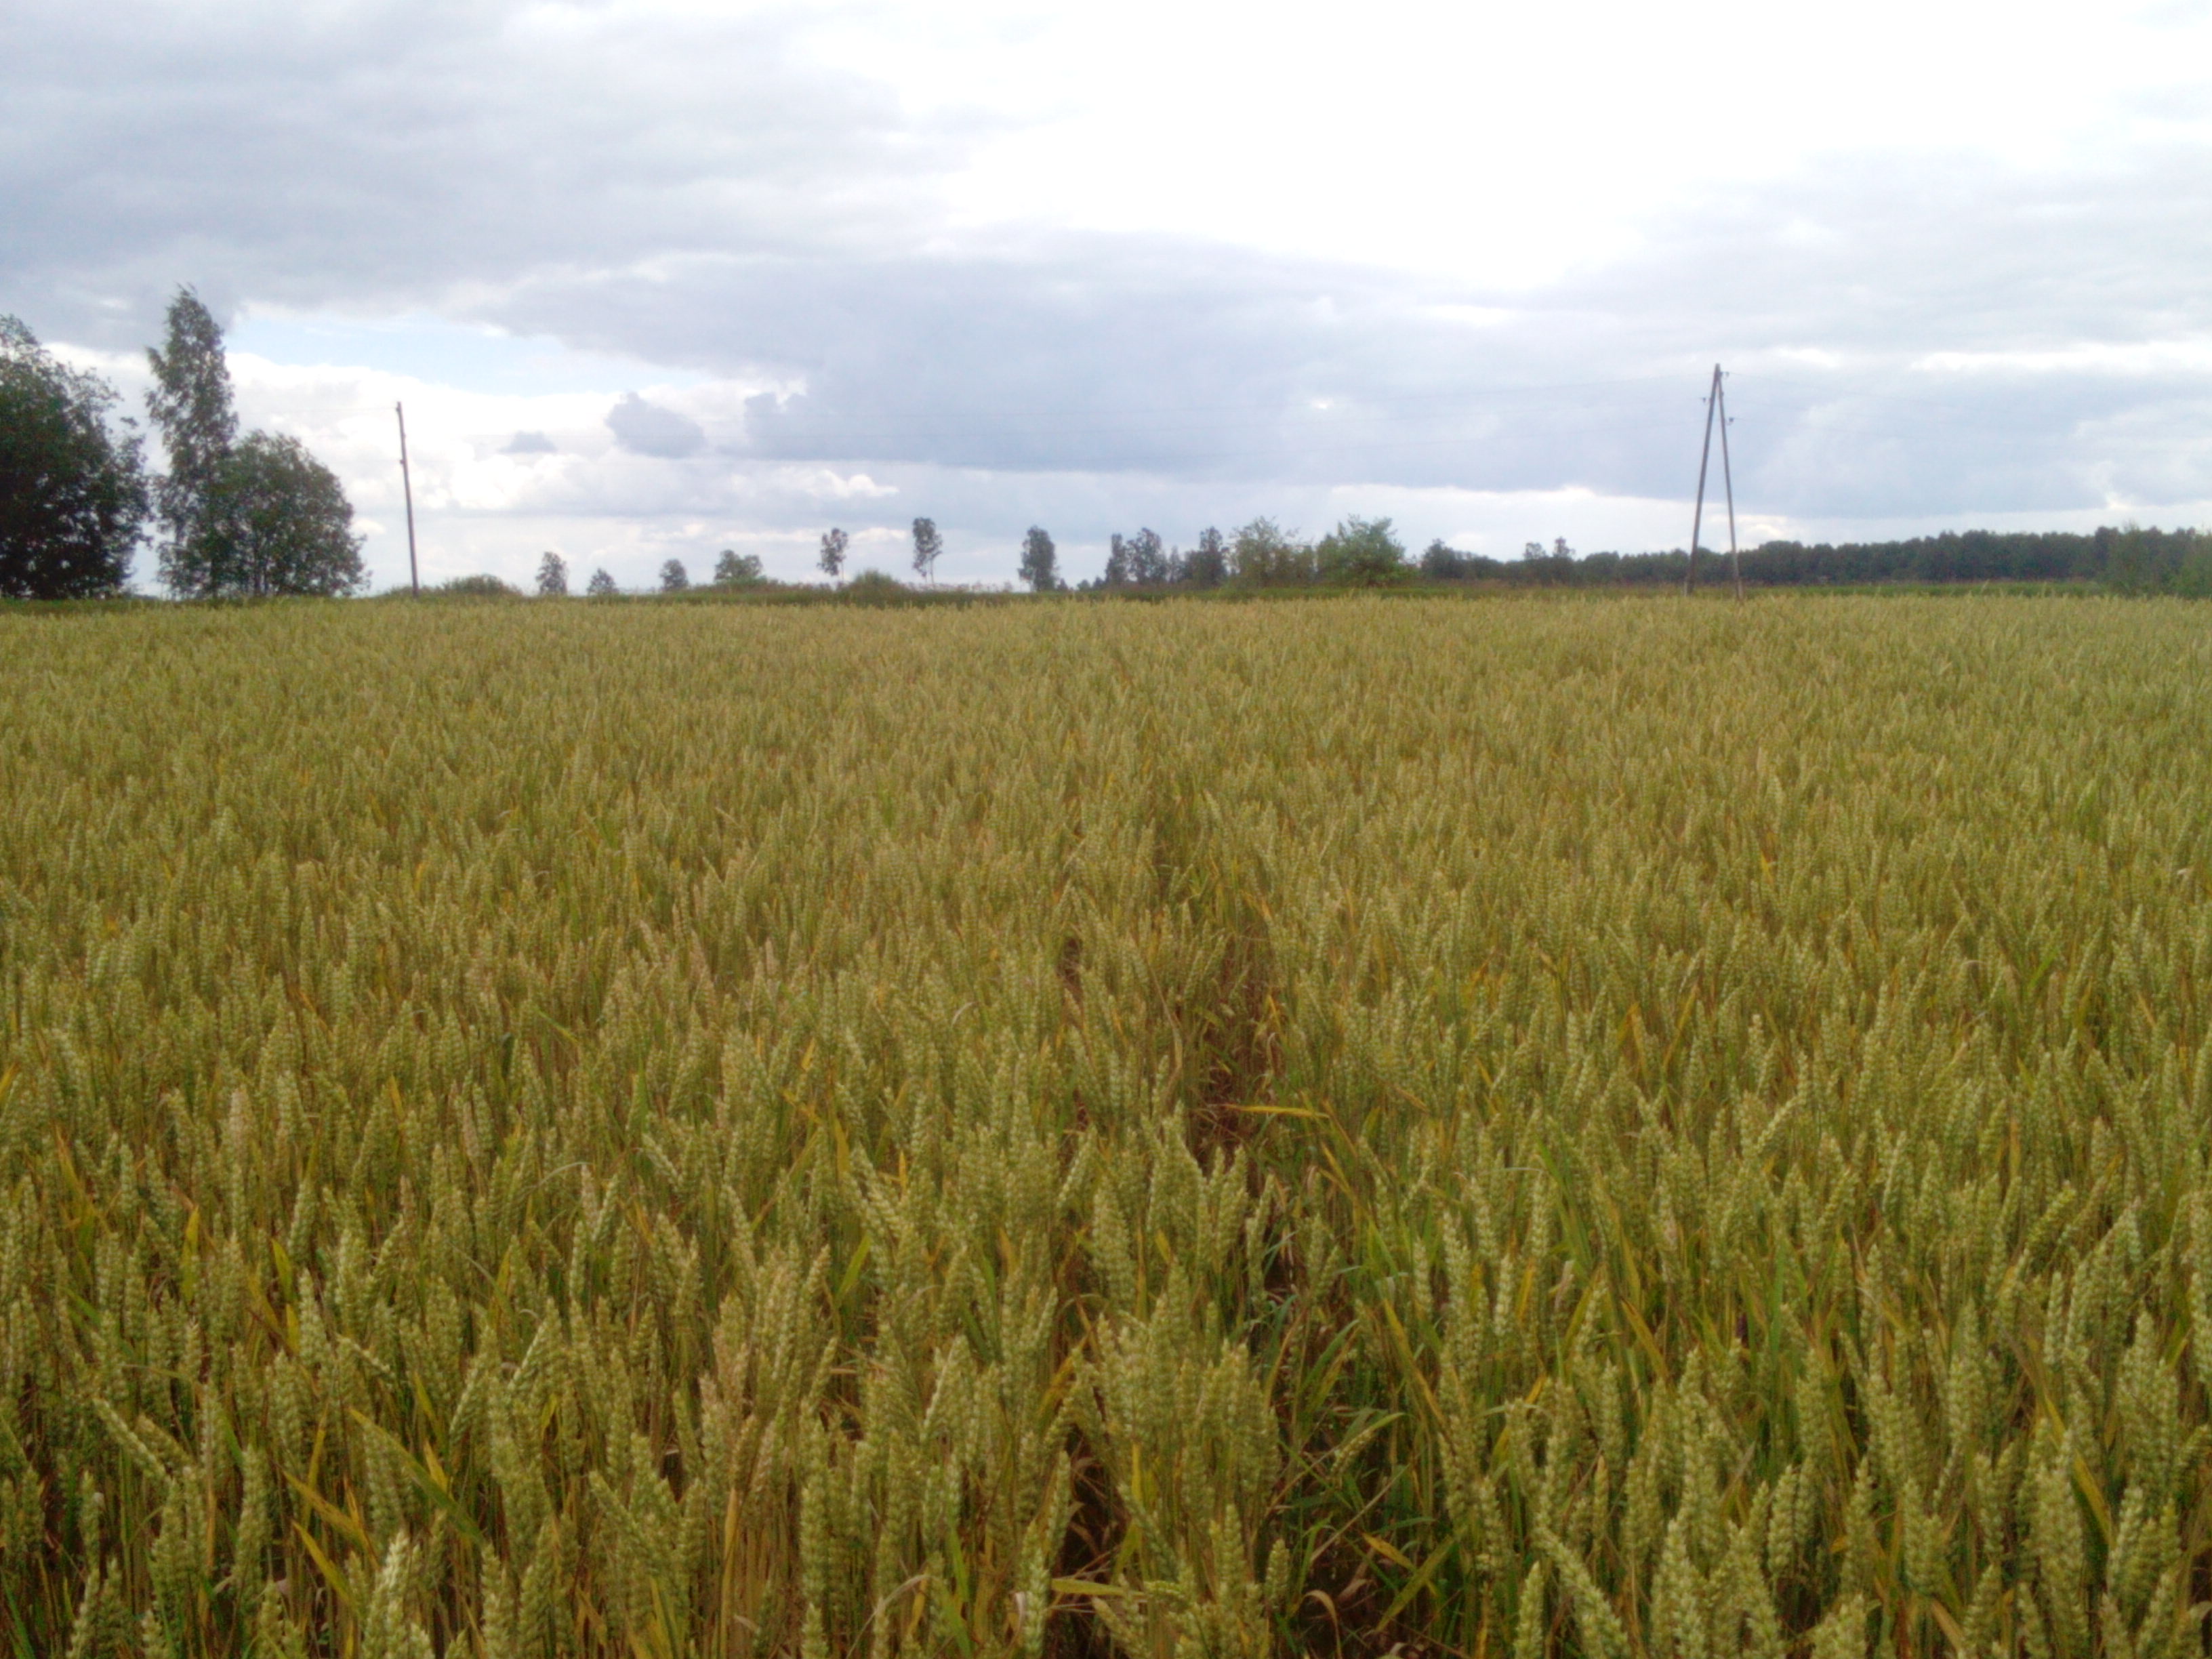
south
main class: Cropland
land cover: Common wheat
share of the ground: > 75 %
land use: Agriculture (excluding fallow land and kitchen gardens)
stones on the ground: < 10 %
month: July
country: LV
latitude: 56.8676
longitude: 22.3067
